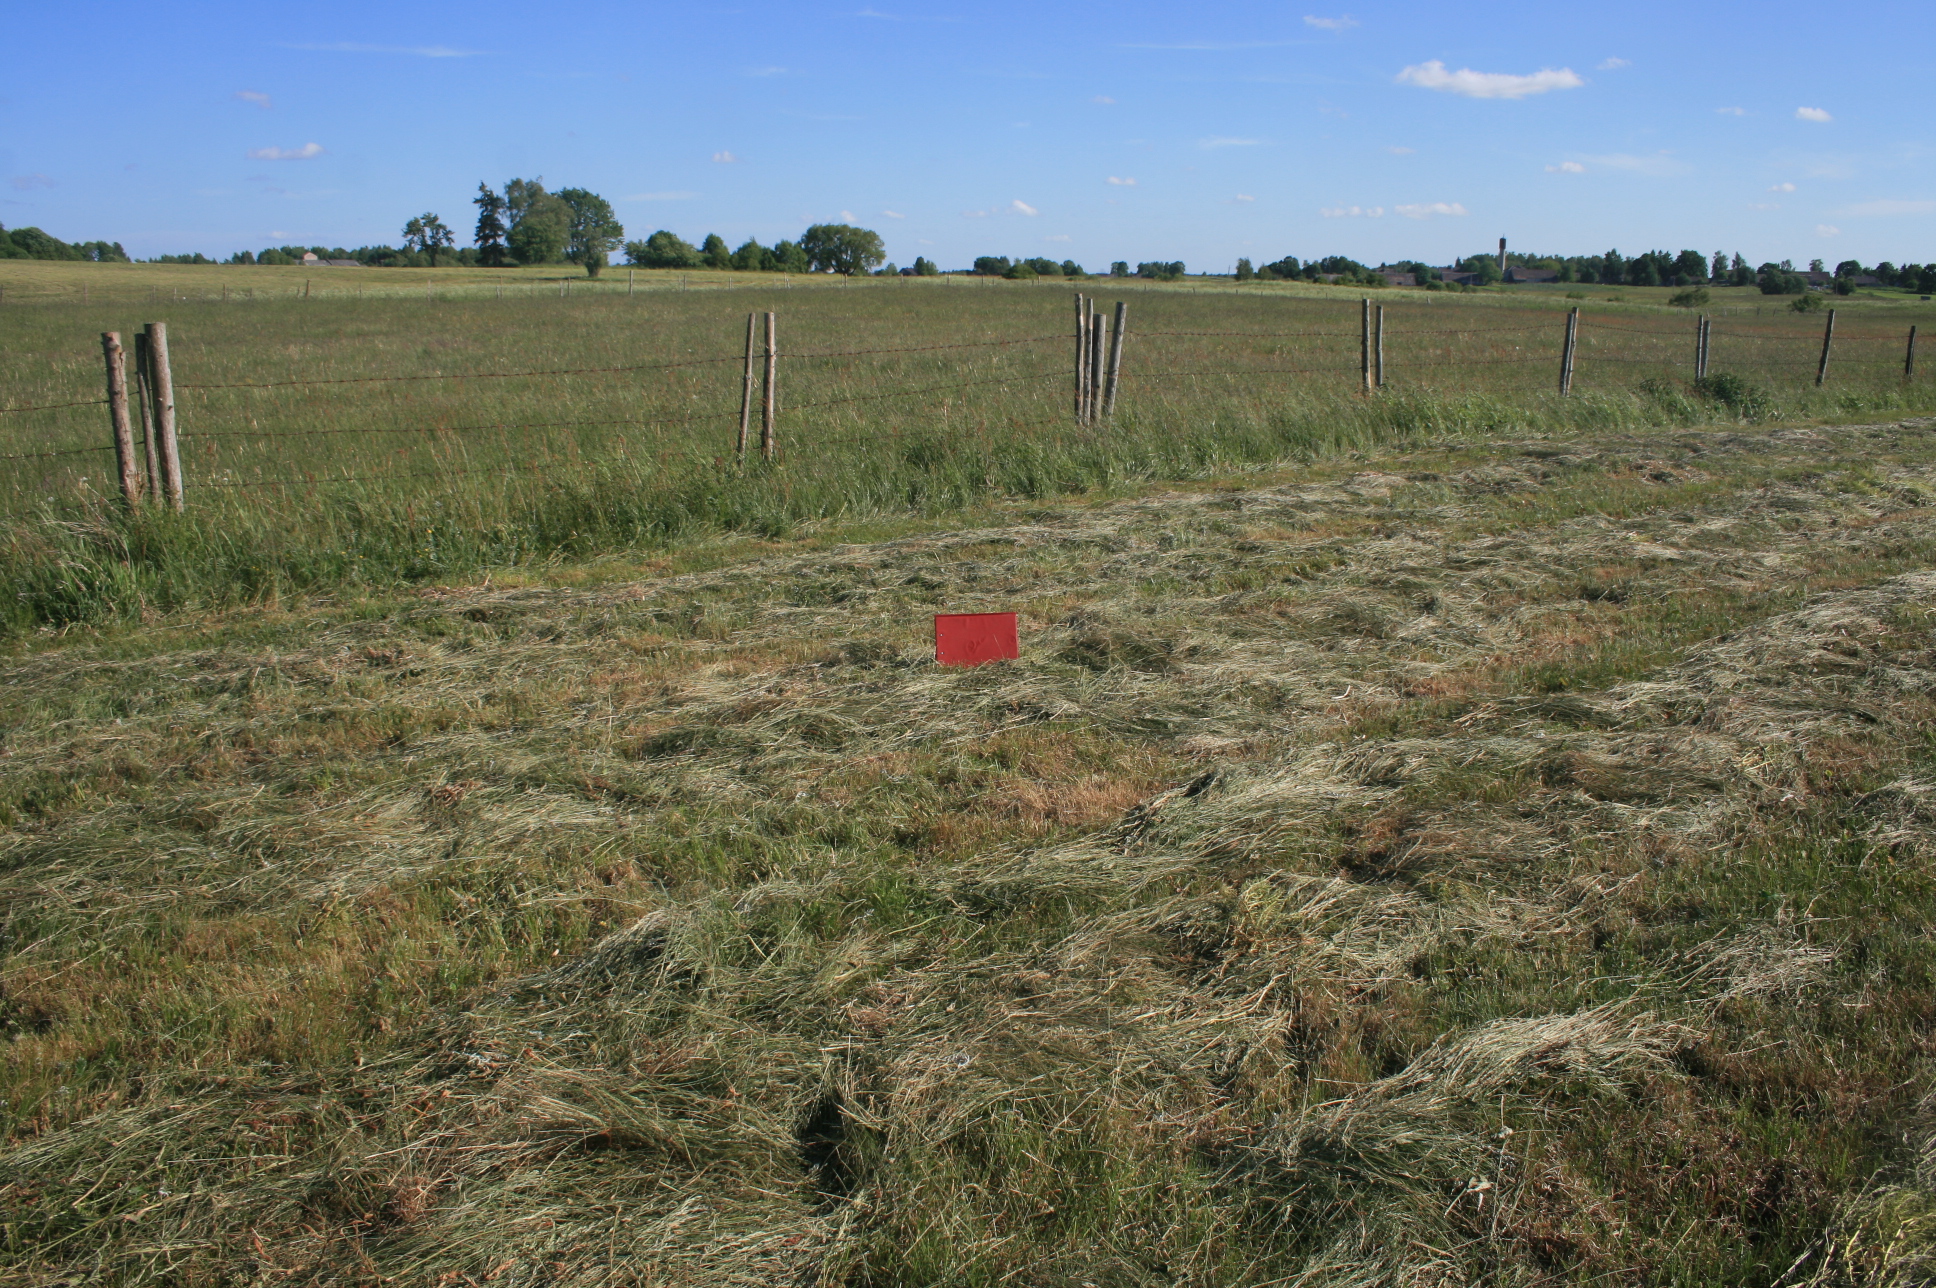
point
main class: Grassland
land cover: Grassland without tree/shrub cover
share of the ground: > 75 %
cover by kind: herbaceous plants 100 %
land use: Agriculture (excluding fallow land and kitchen gardens)
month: June
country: LT
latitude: 55.8206
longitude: 22.3959
